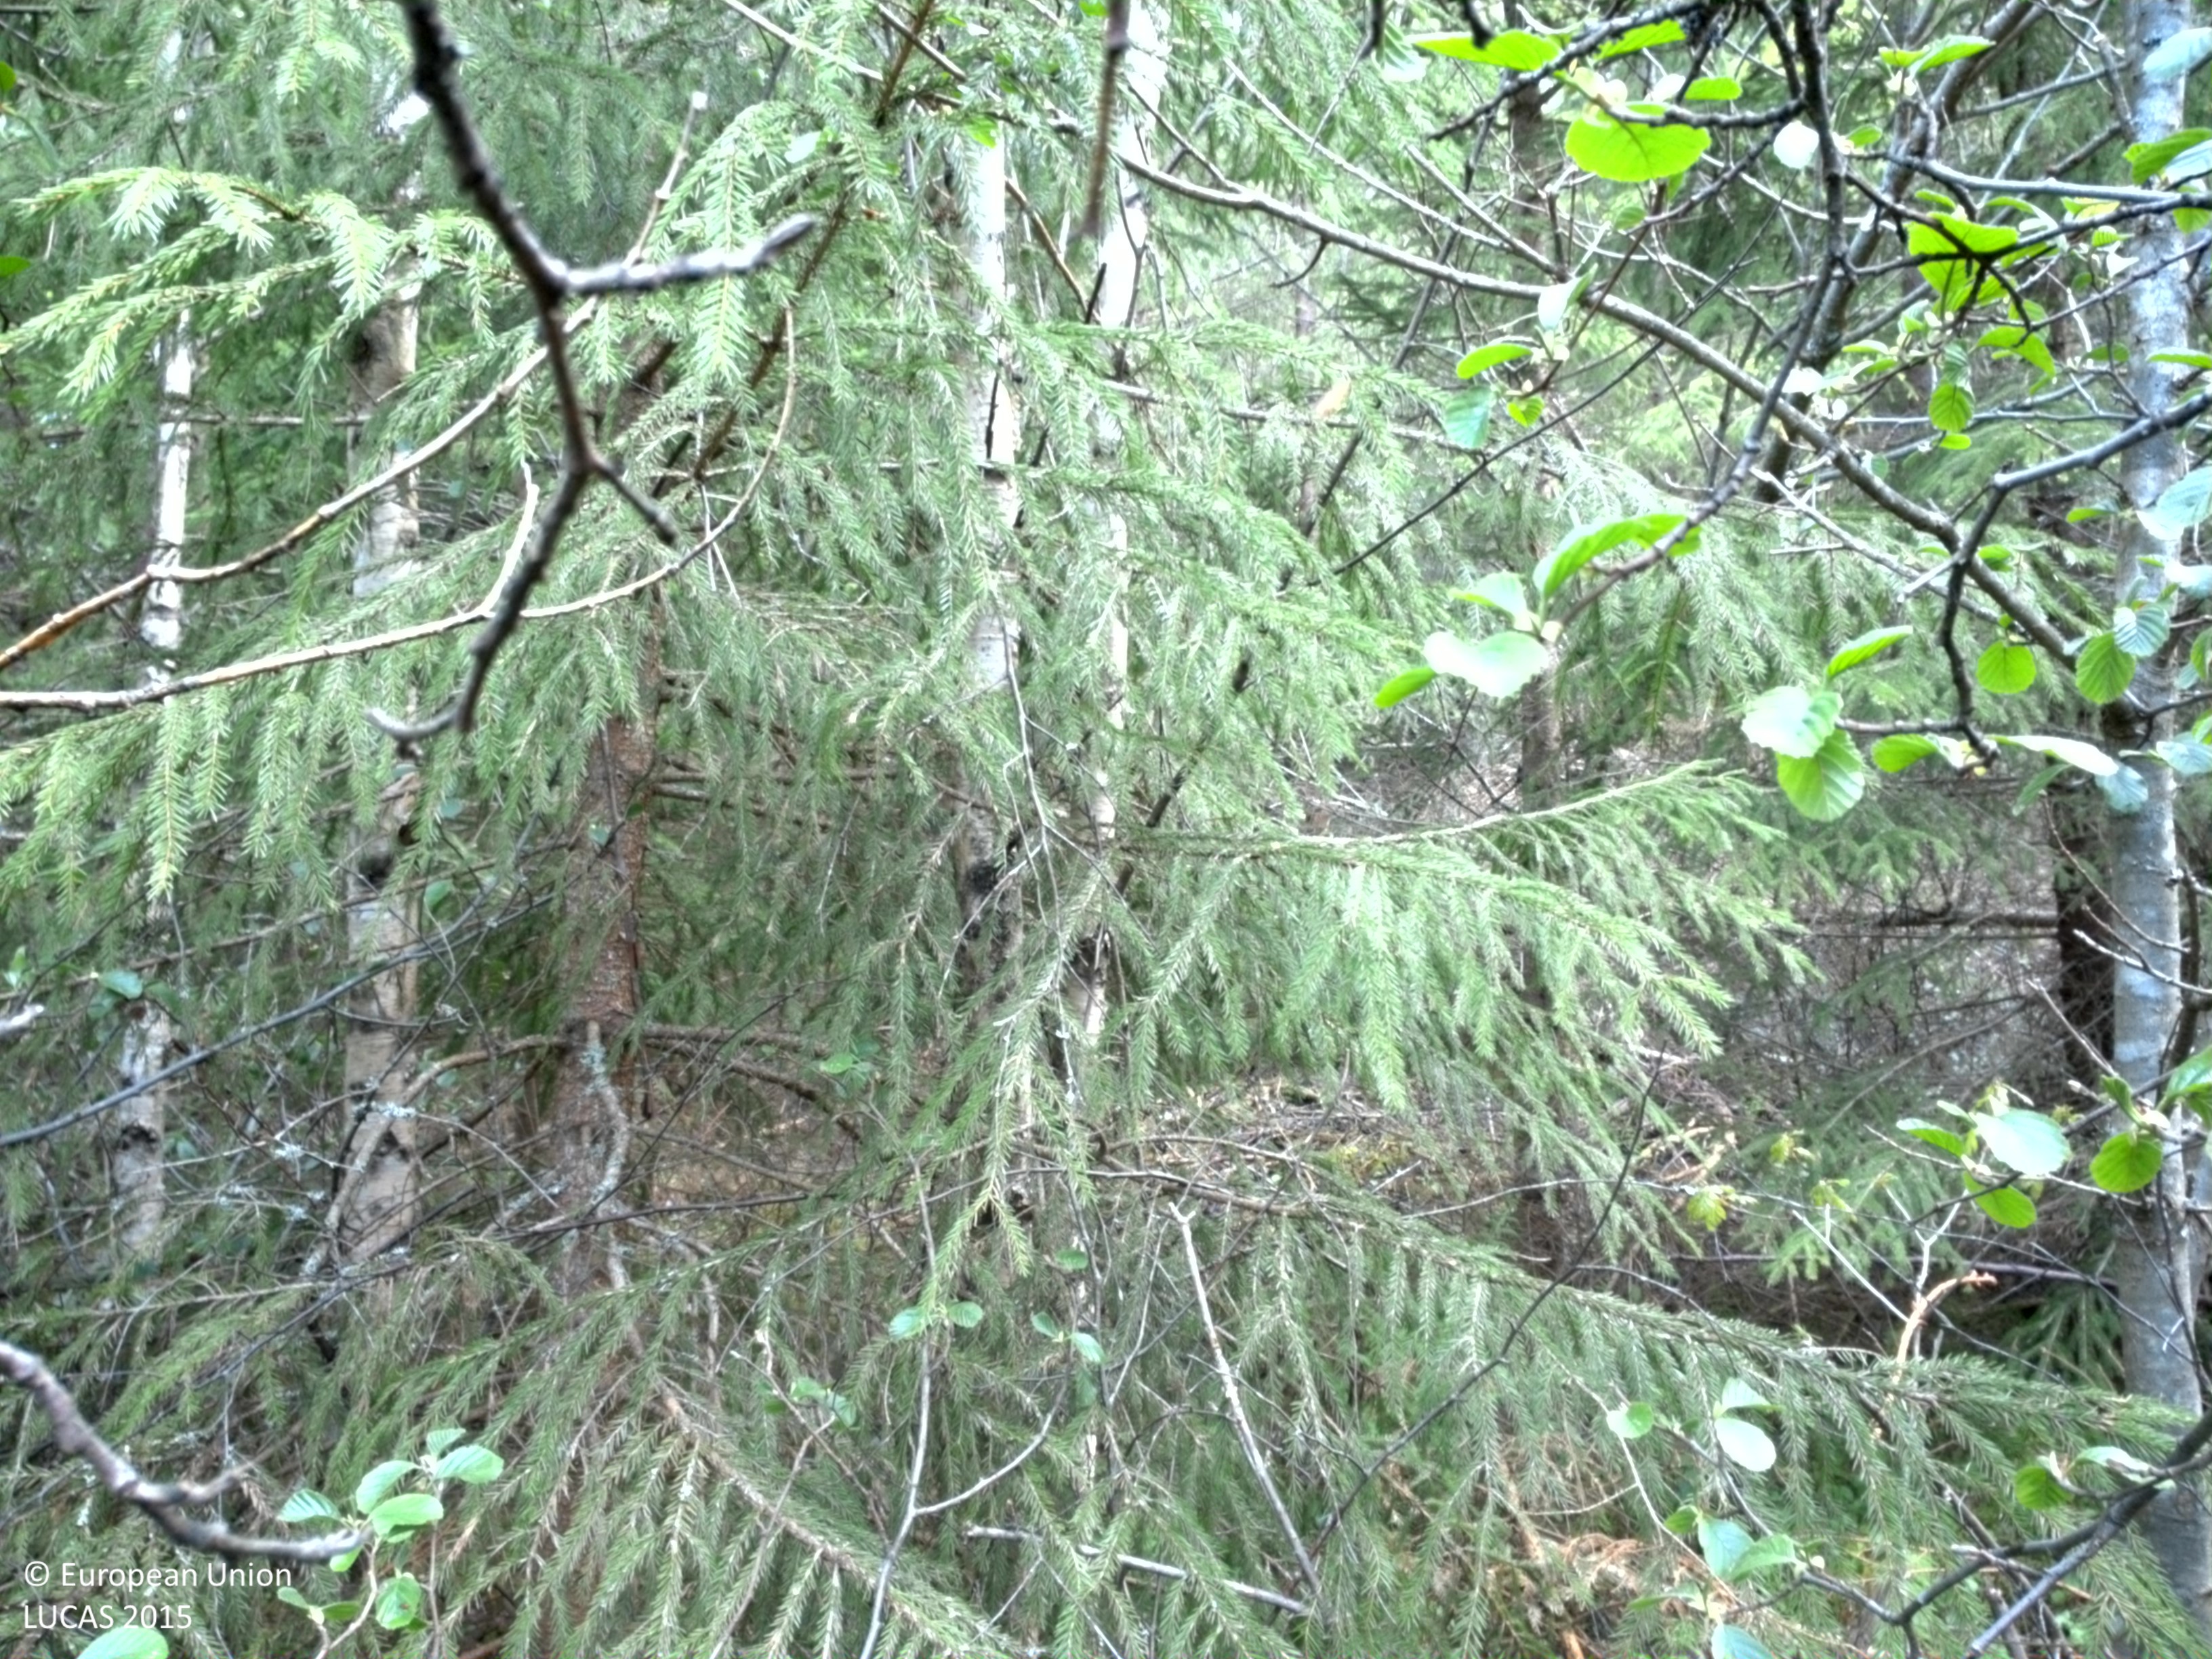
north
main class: Woodland
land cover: Spruce dominated mixed woodland
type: boreal forest
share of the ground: > 75 %
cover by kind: coniferous forest trees 40 %, broadleaved forest trees 35 %, lichens and mosses 15 %, shrubs 5 %, herbaceous plants 5 %
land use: Forestry
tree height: > 5 m
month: May
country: SE
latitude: 57.4077
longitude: 15.4065
